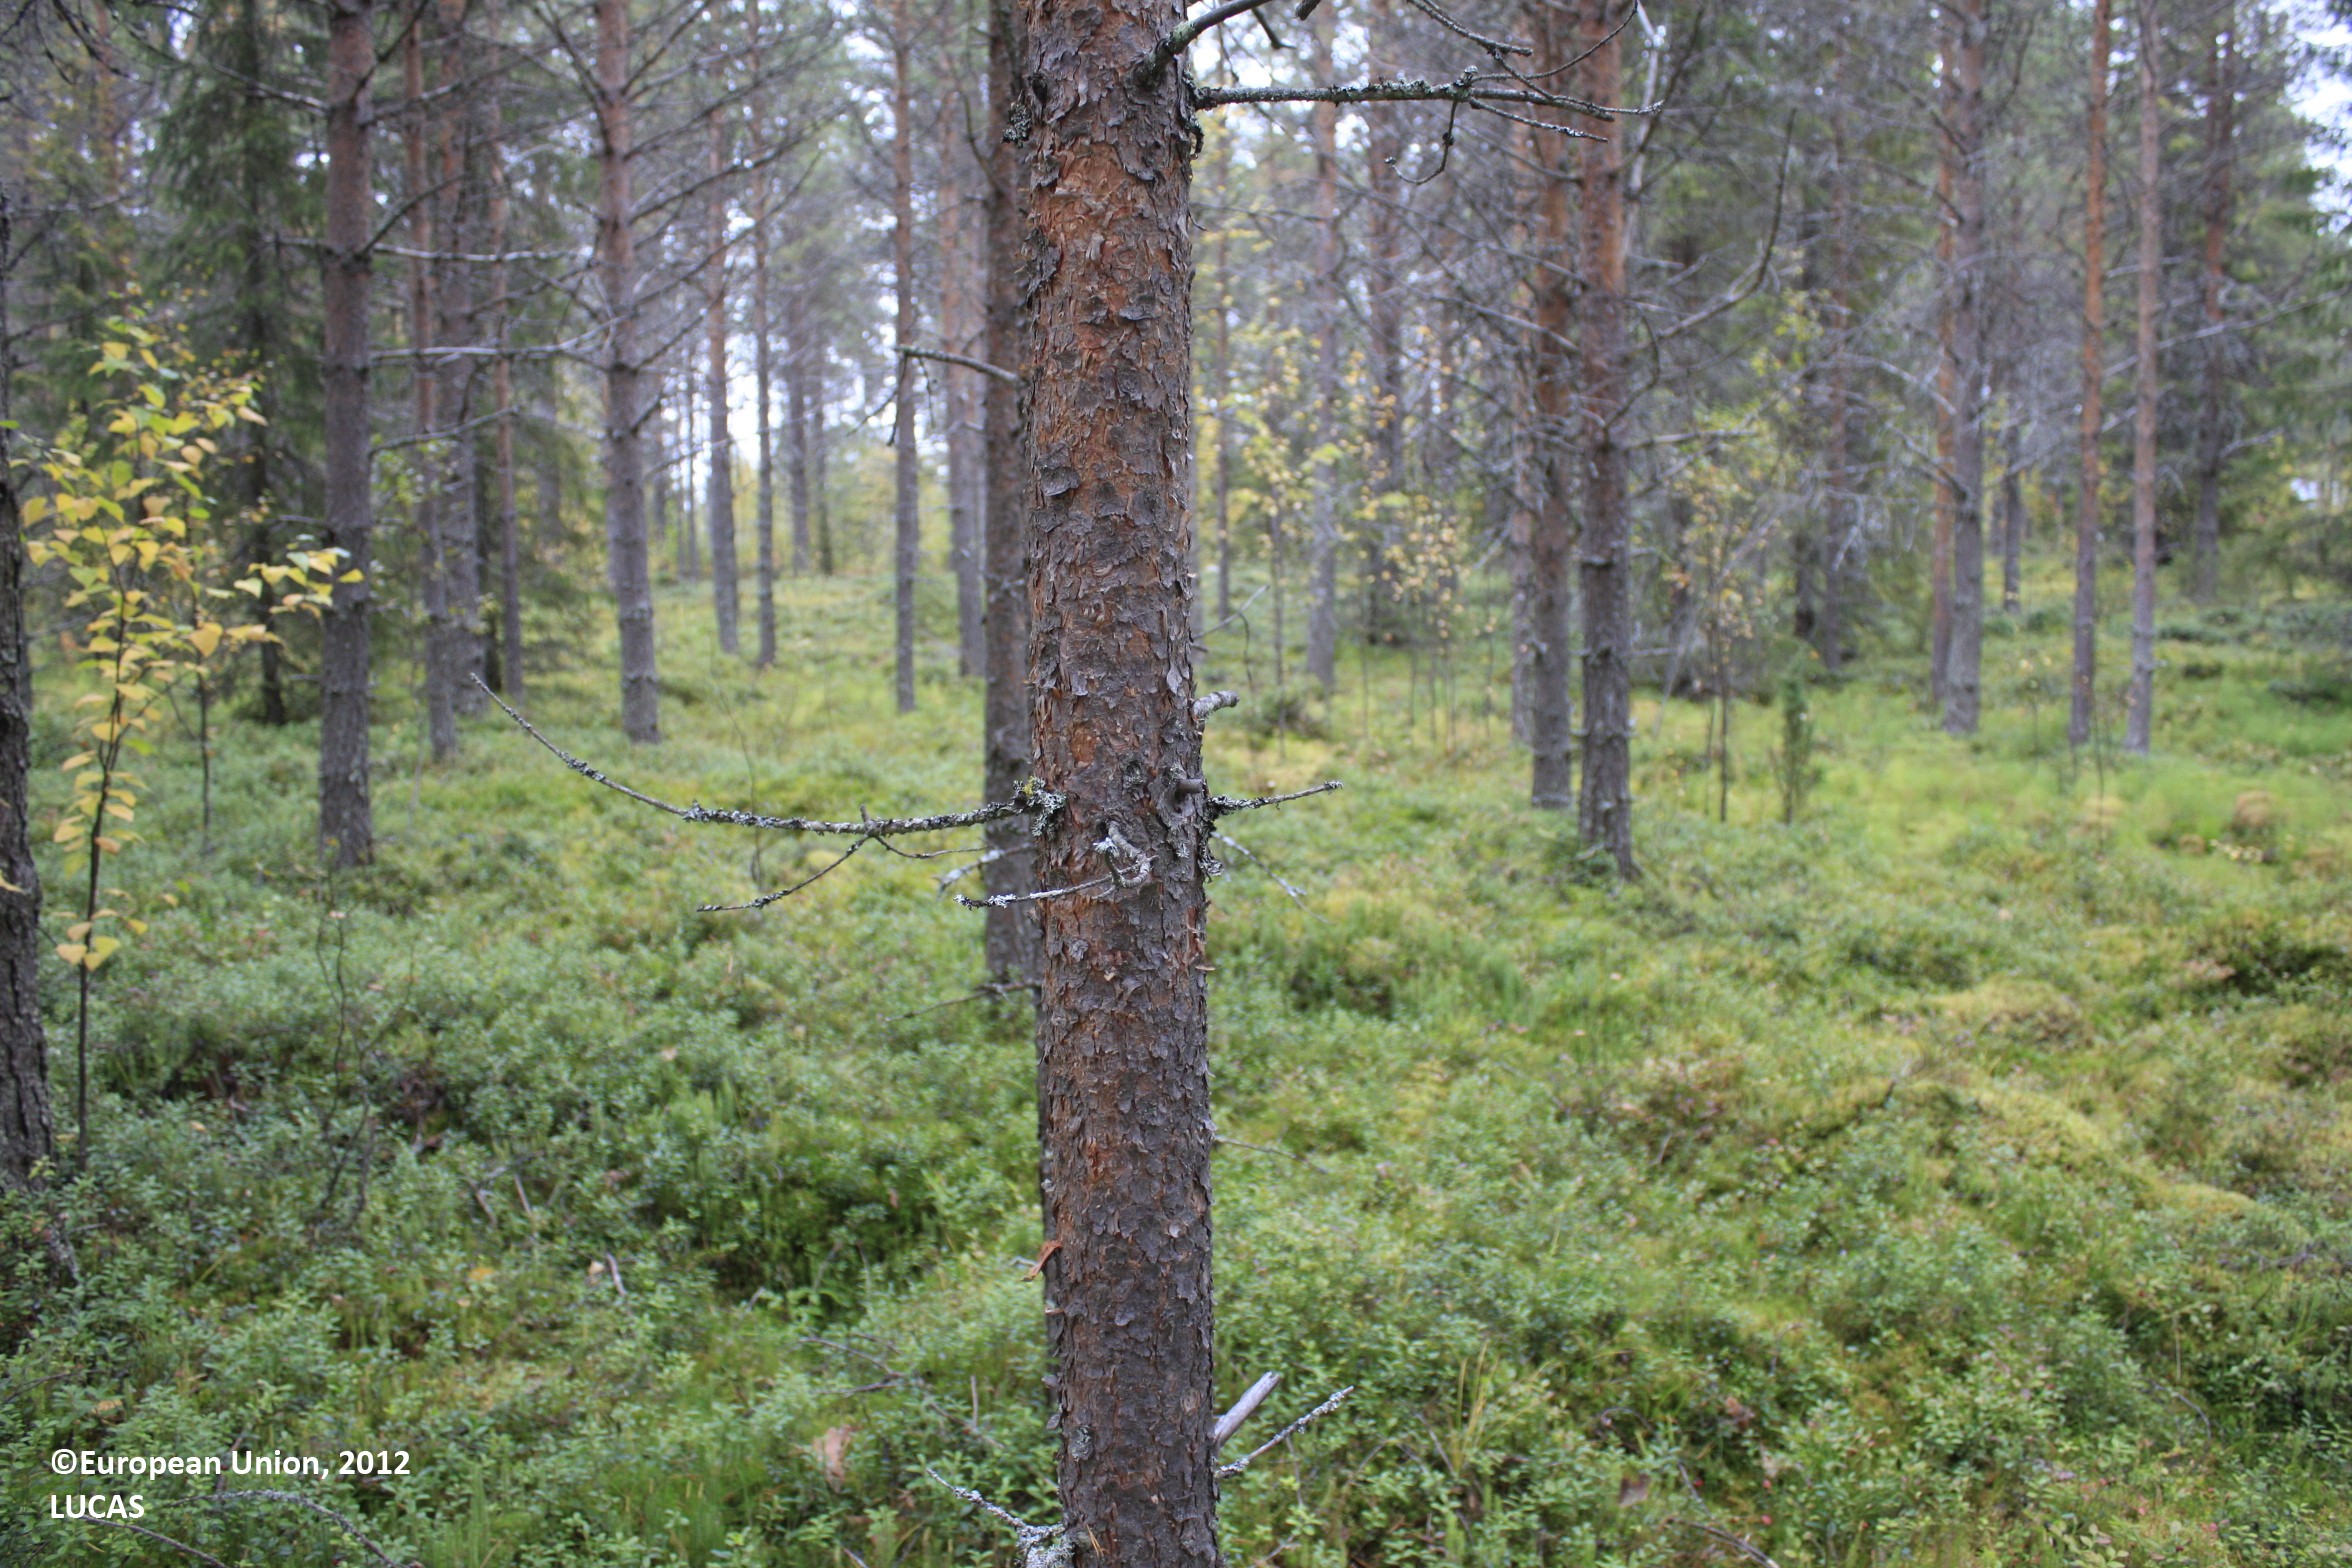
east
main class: Woodland
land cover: Pine dominated coniferous woodland
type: boreal forest
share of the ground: 50 - 75 %
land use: Forestry
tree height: > 5 m
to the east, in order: Pine dominated coniferous woodland; Artificial constructions in urban areas; Pine dominated mixed woodland
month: September
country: FI
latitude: 65.5451
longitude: 27.2451
